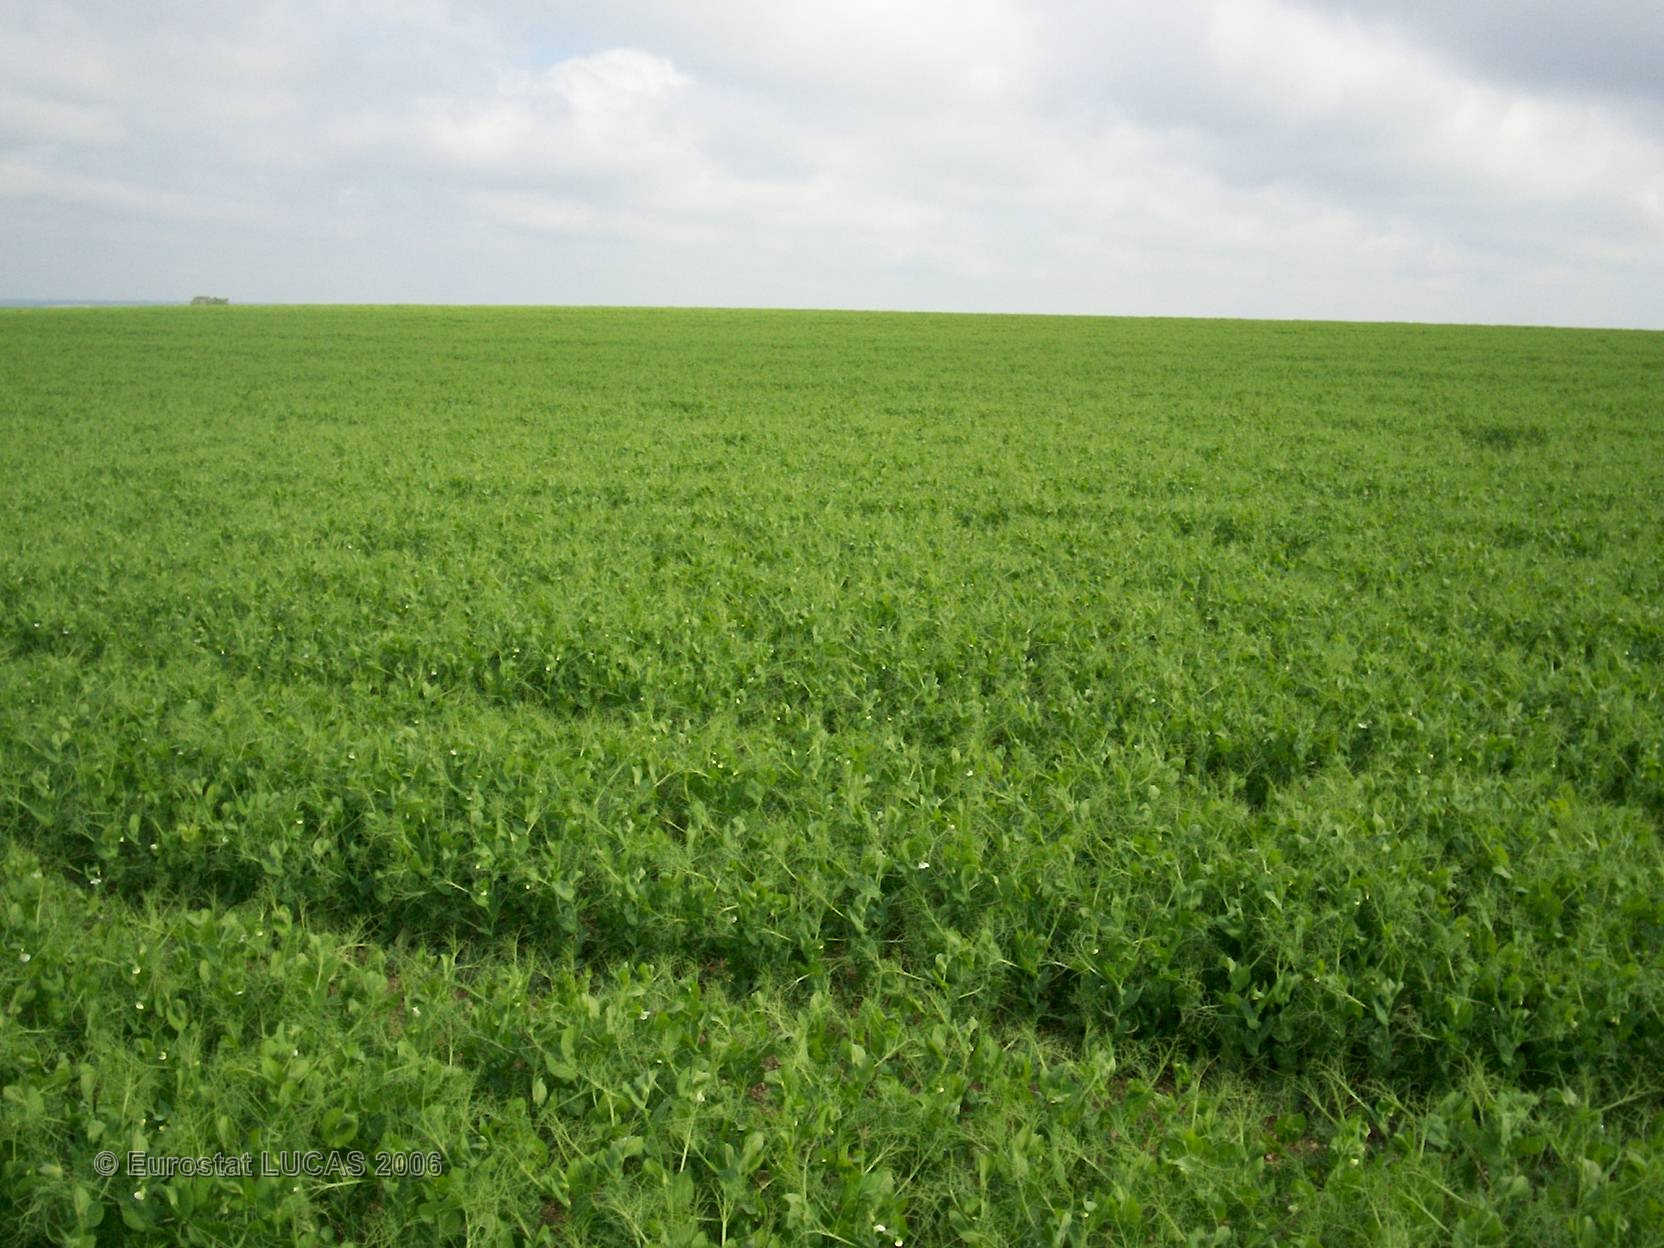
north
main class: Cropland
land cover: Dry pulses
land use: Agriculture (excluding fallow land and kitchen gardens)
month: June
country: FR
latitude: 48.5696
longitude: 4.4270
